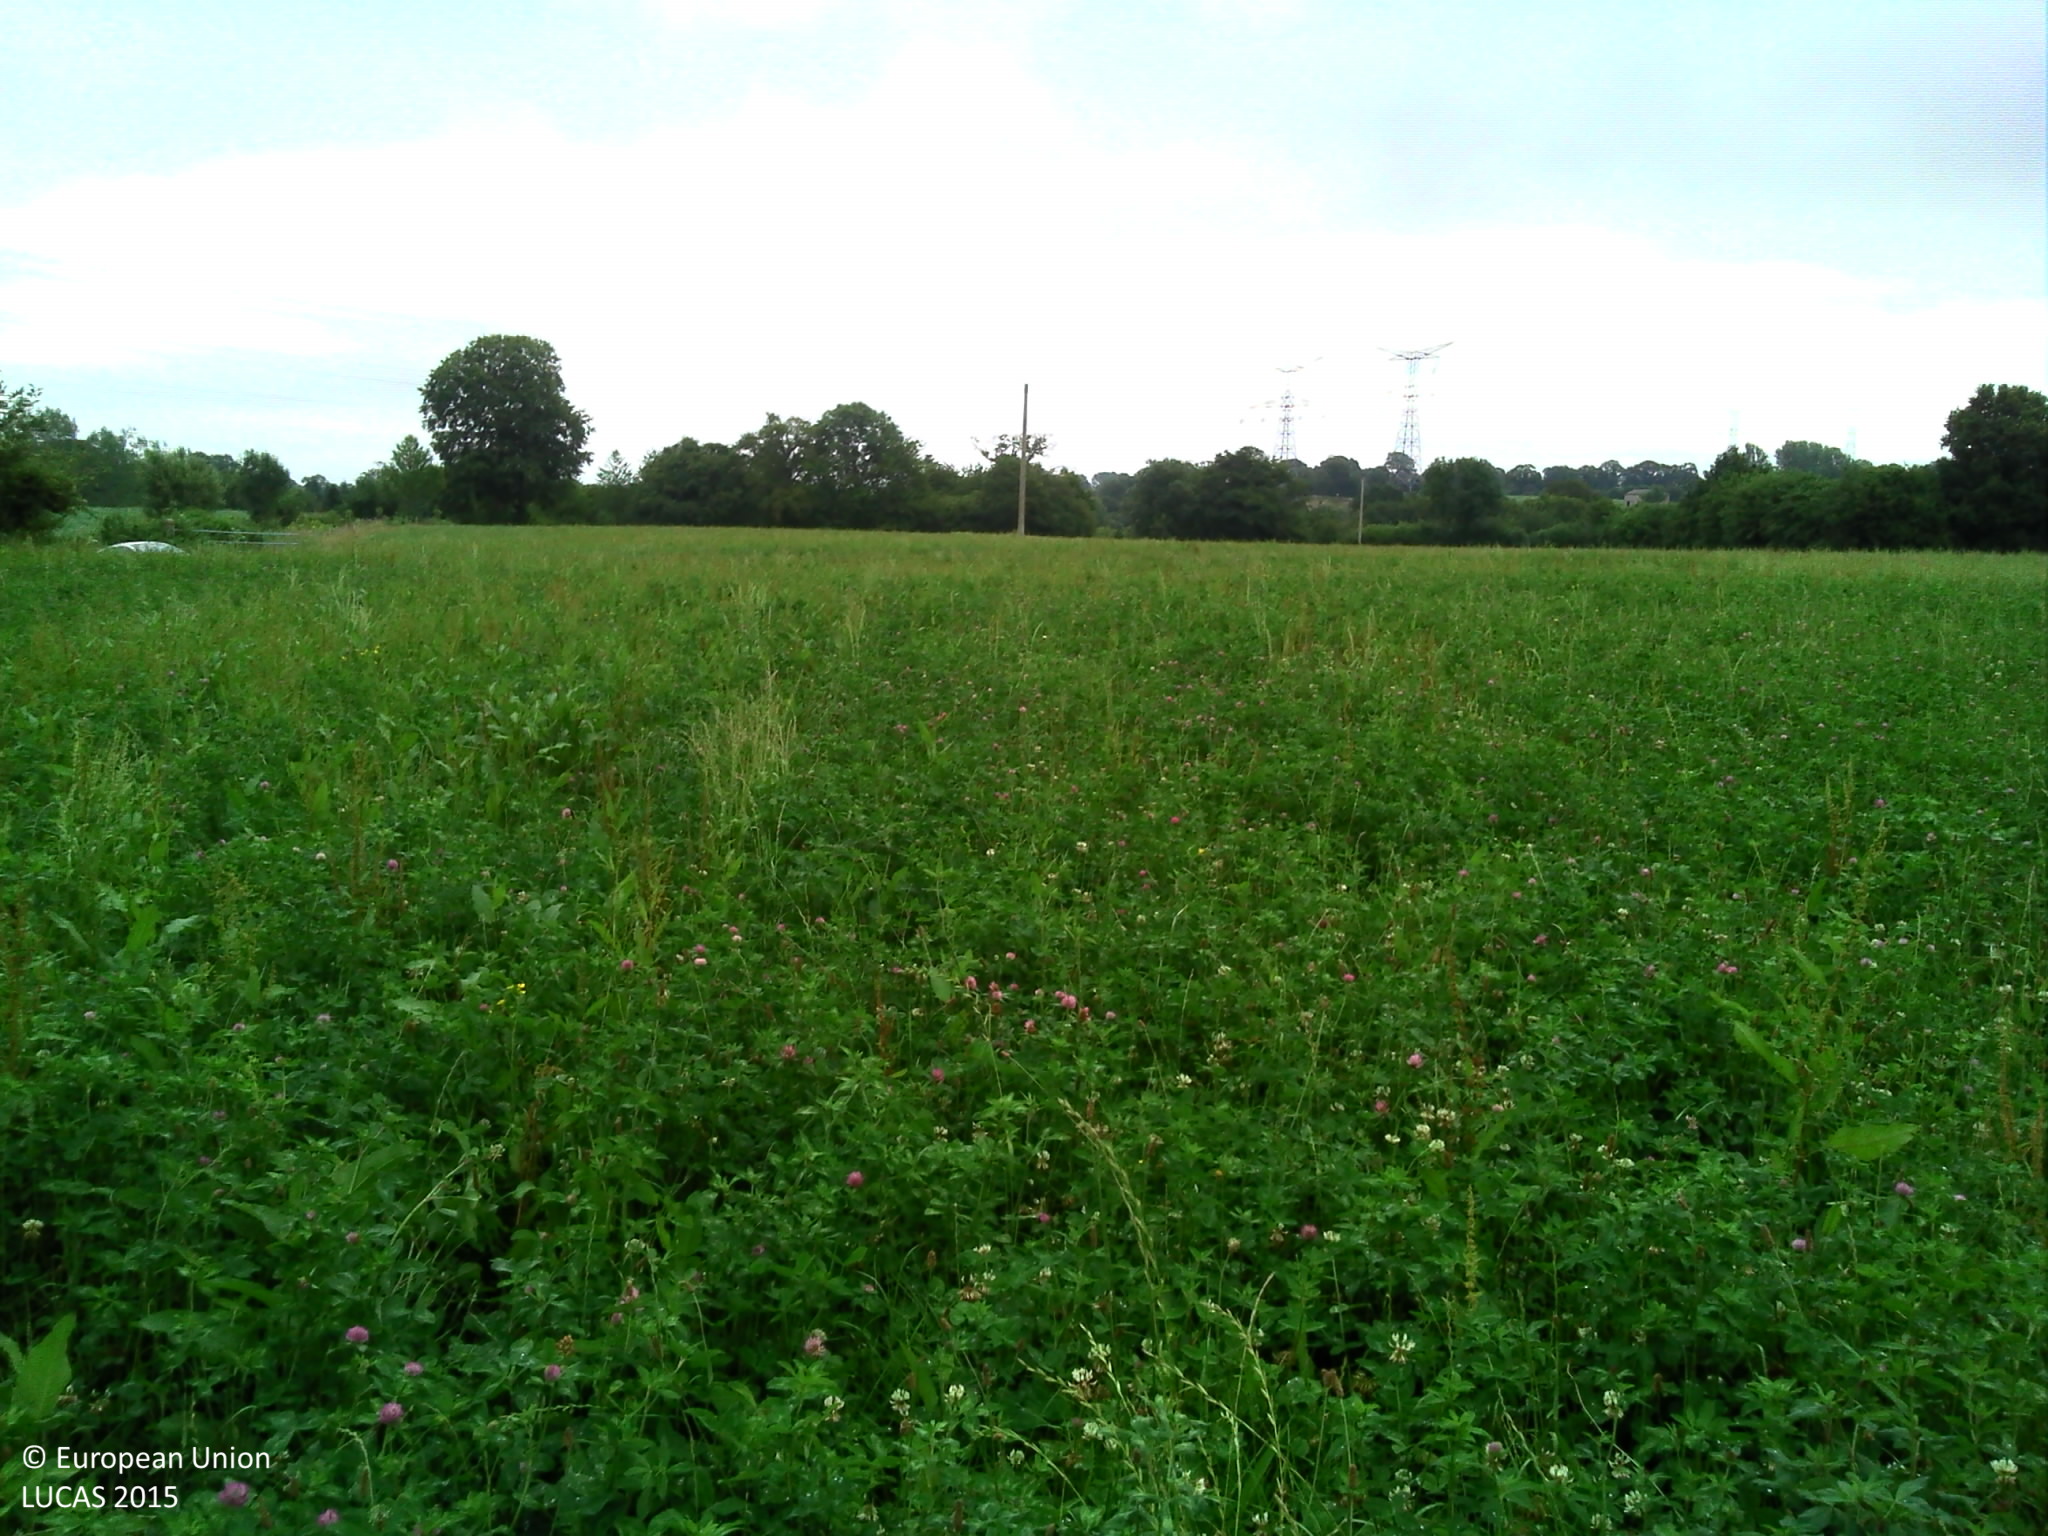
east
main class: Cropland
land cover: Other leguminous and mixtures for fodder
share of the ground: > 75 %
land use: Agriculture (excluding fallow land and kitchen gardens)
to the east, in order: Other leguminous and mixtures for fodder; Broadleaved woodland; Ditches and canals; Grass margins; Paved roads, cycling and walking lanes; Grass margins; Electric lines; Abandoned hedges; Spontaneously vegetated surfaces; Grassland without tree/shrub cover
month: July
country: FR
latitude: 49.1275
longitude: -1.3247
